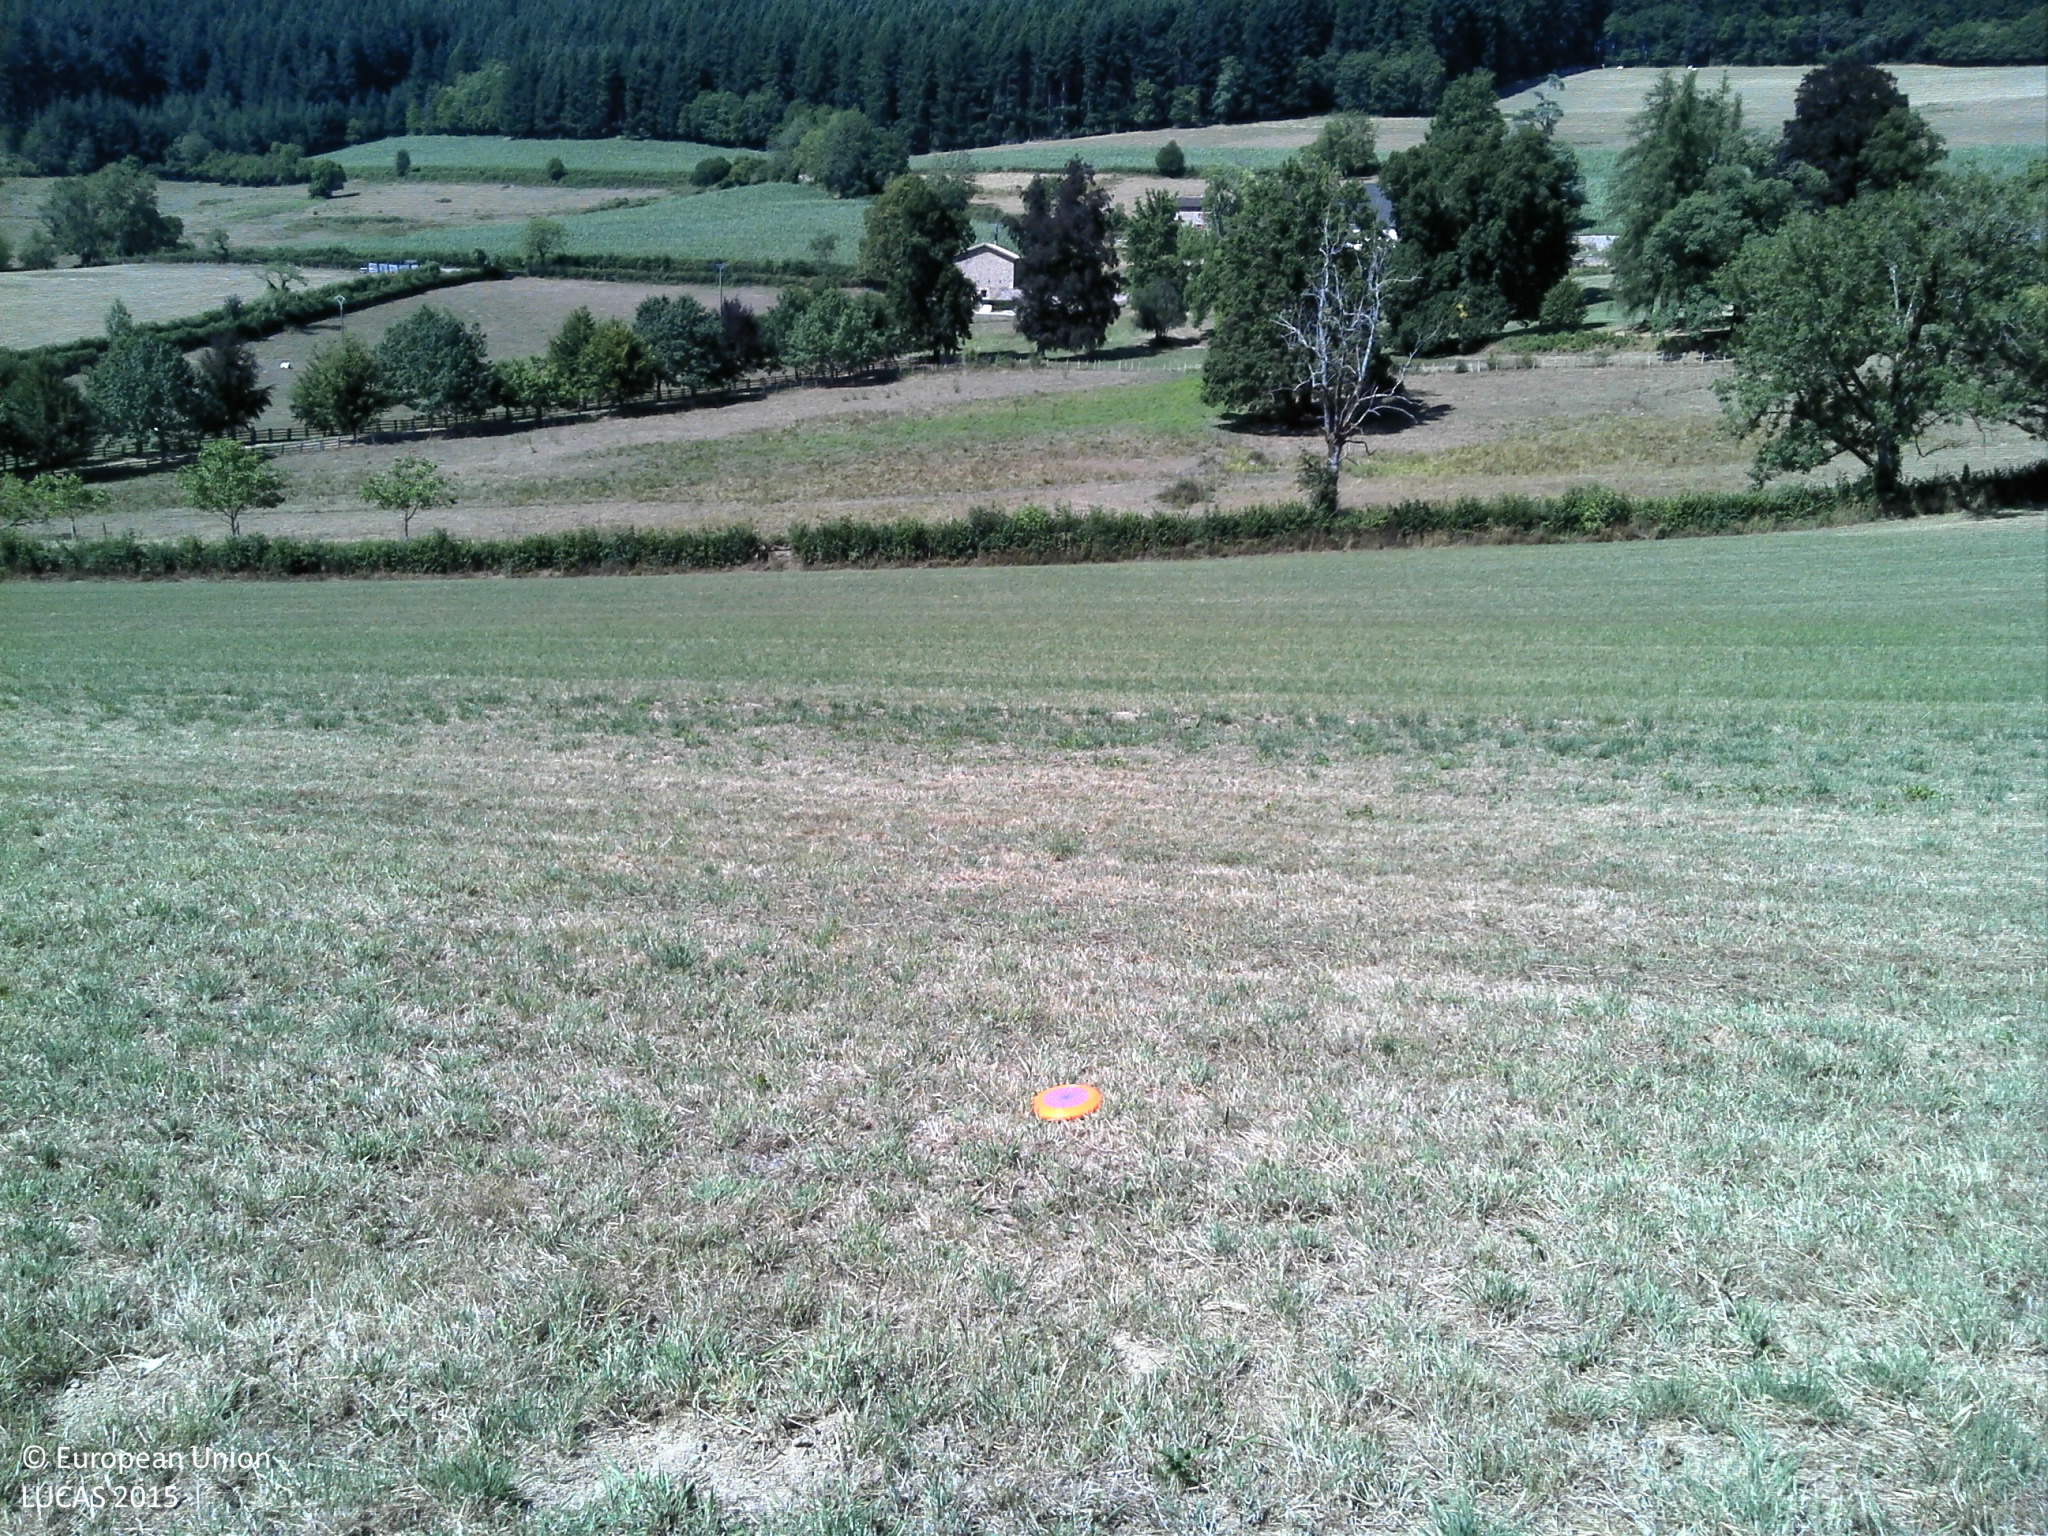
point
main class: Grassland
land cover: Grassland without tree/shrub cover
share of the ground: > 75 %
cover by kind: herbaceous plants 100 %
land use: Agriculture (excluding fallow land and kitchen gardens)
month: August
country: FR
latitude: 46.2054
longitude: 4.4159
